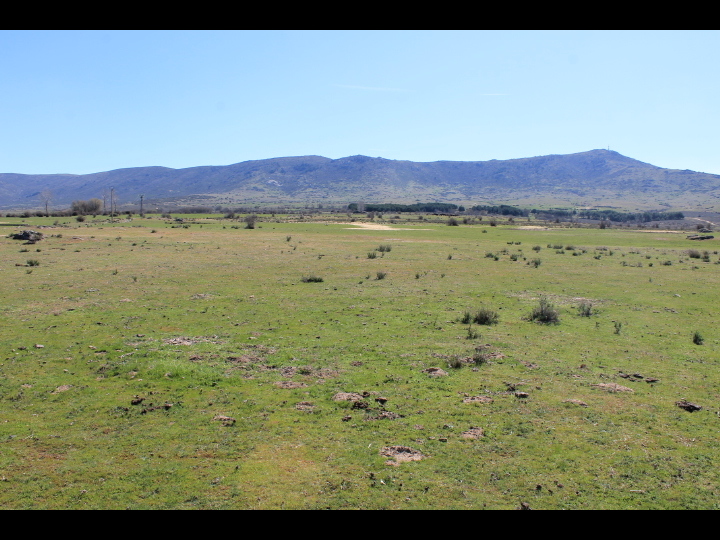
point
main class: Grassland
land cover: Grassland without tree/shrub cover
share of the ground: > 75 %
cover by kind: herbaceous plants 95 %, unconsolidated bare surface 5 %
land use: Agriculture (excluding fallow land and kitchen gardens)
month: April
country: ES
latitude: 40.9575
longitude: -4.0329
